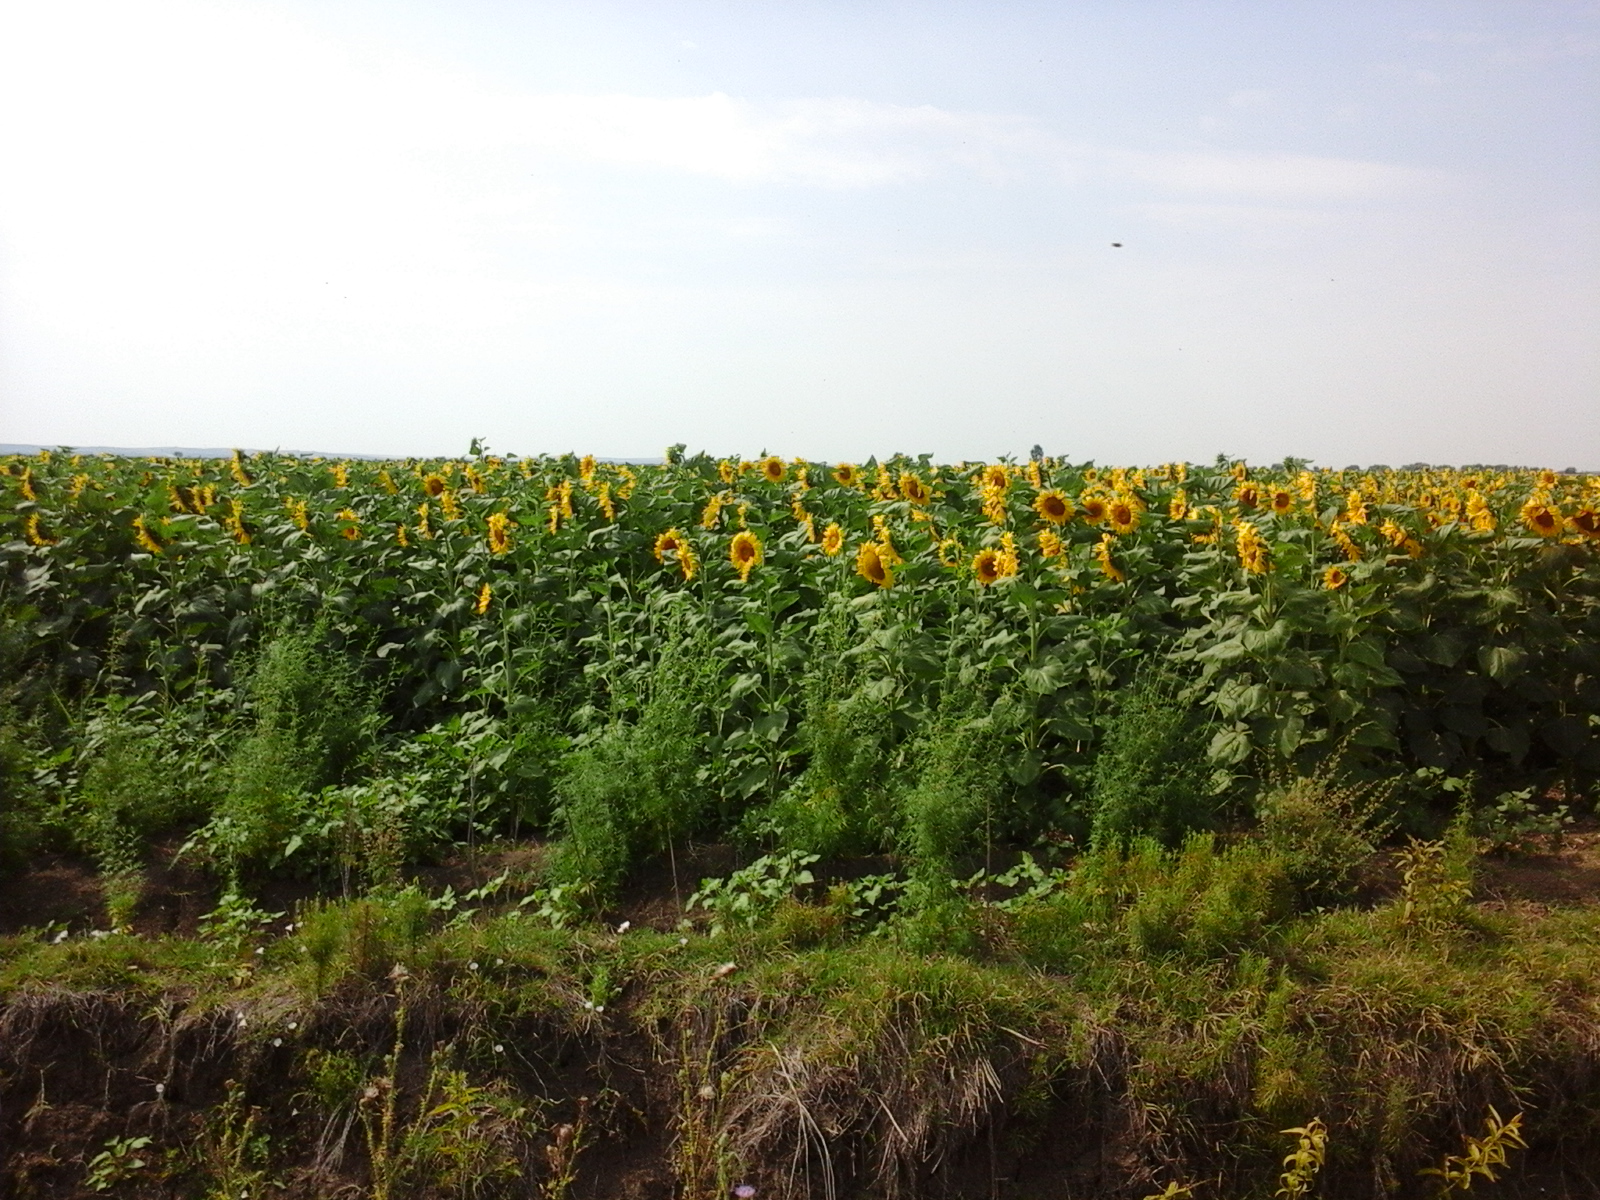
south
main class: Cropland
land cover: Sunflower
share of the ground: > 75 %
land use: Agriculture (excluding fallow land and kitchen gardens)
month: July
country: RO
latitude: 44.4895
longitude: 28.0273
